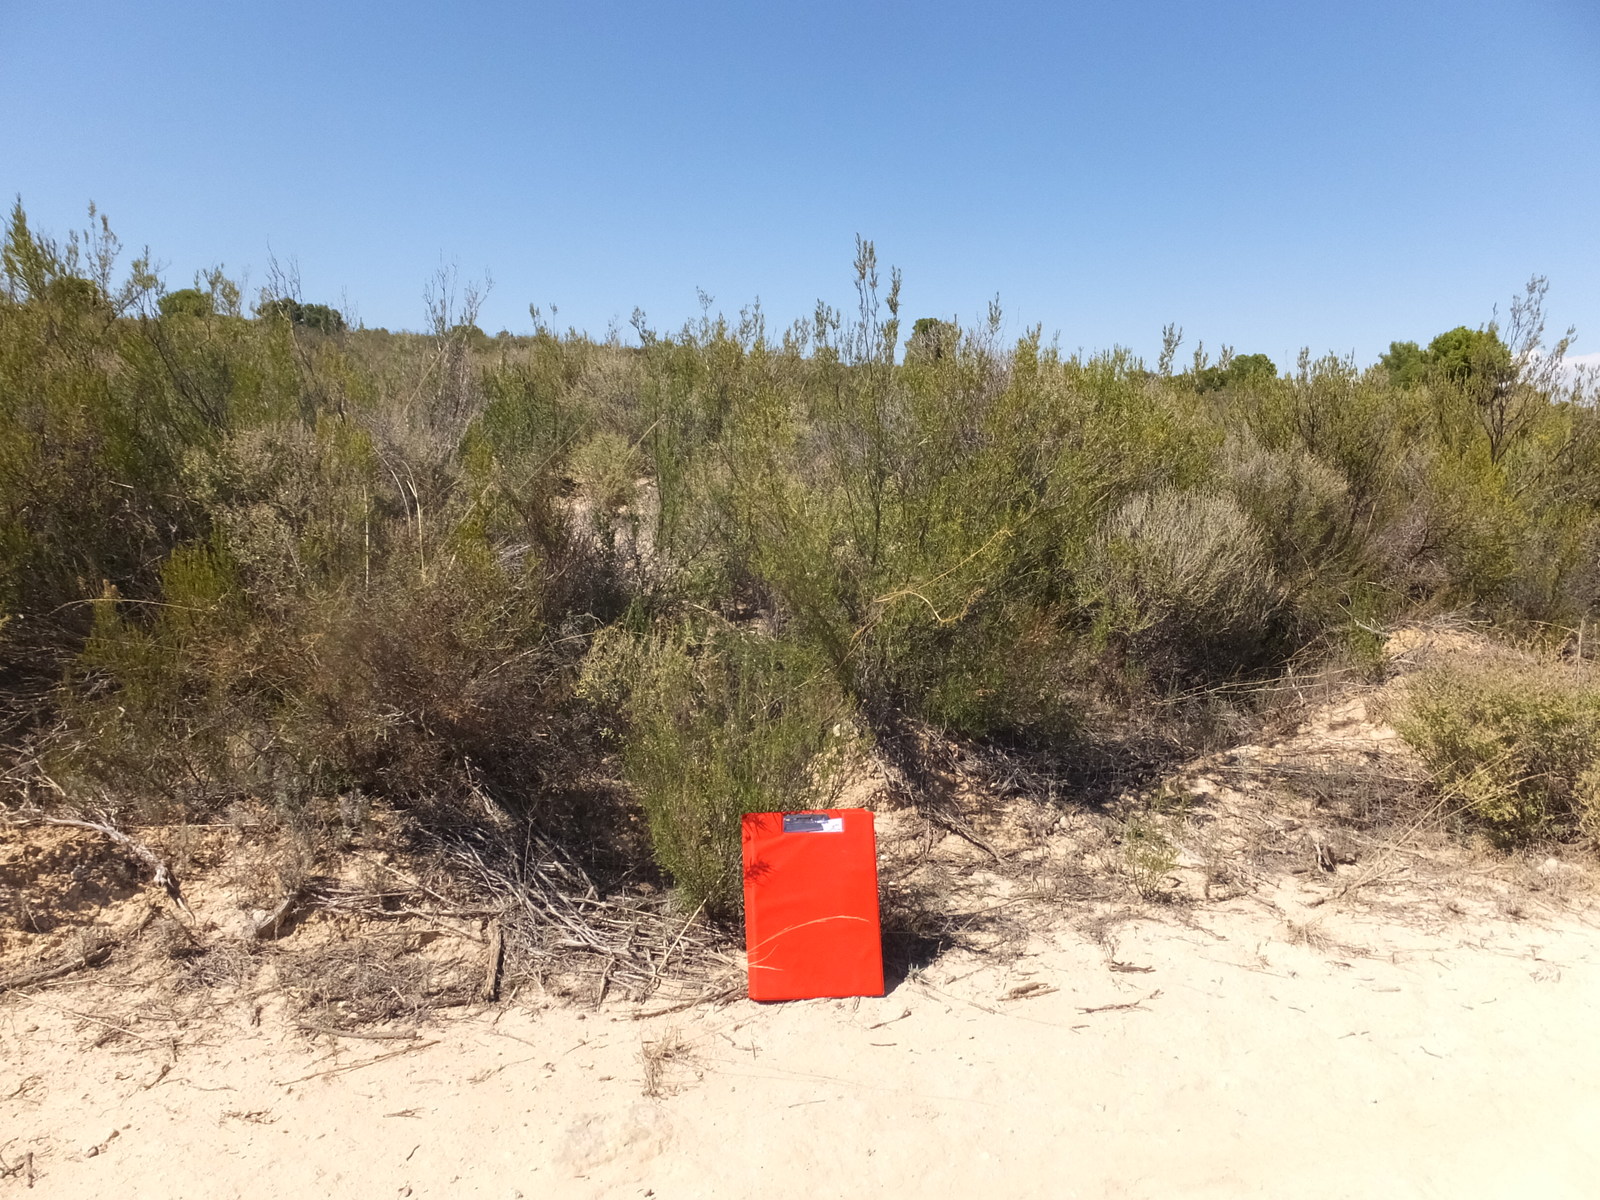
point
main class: Shrubland
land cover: Shrubland without tree cover
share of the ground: > 75 %
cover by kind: shrubs 80 %, herbaceous plants 10 %, consolidated bare surface 10 %
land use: Semi-natural and natural areas not in use
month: August
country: ES
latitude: 41.2399
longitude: 0.0967
